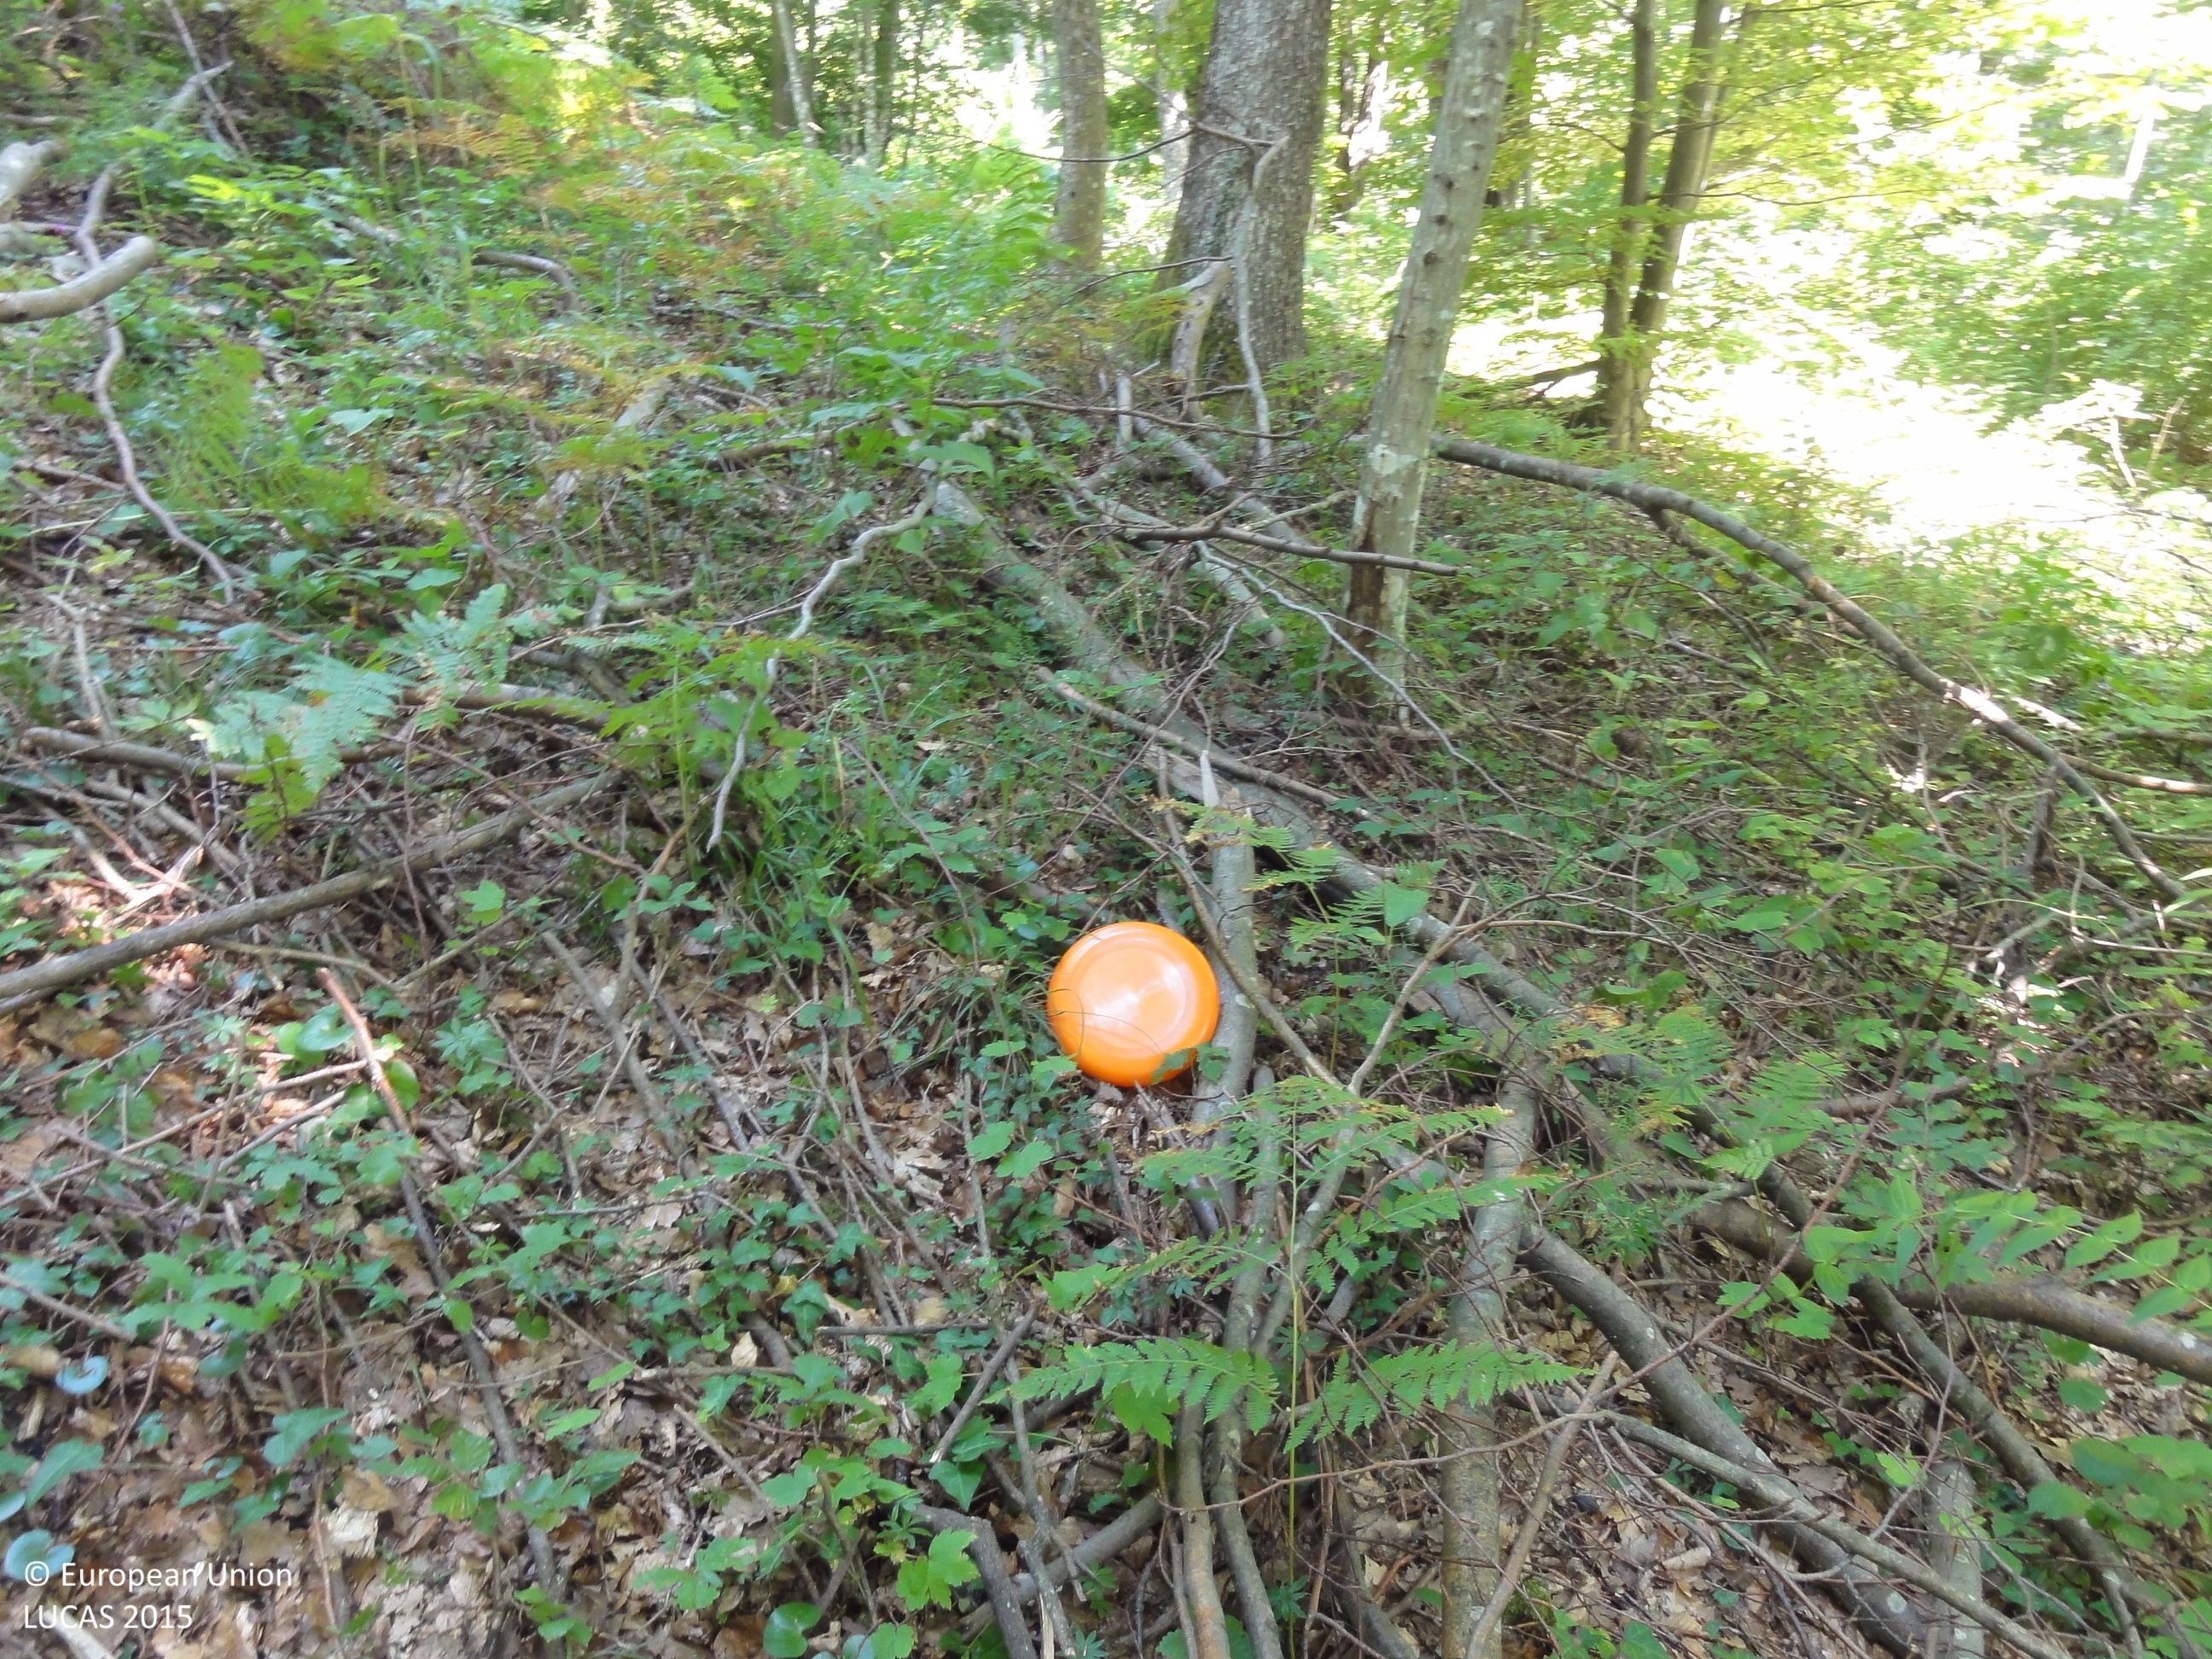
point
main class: Woodland
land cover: Broadleaved woodland
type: beech forest
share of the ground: > 75 %
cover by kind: broadleaved forest trees 100 %
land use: Forestry
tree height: > 5 m
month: August
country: SI
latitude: 45.9988
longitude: 15.0197
